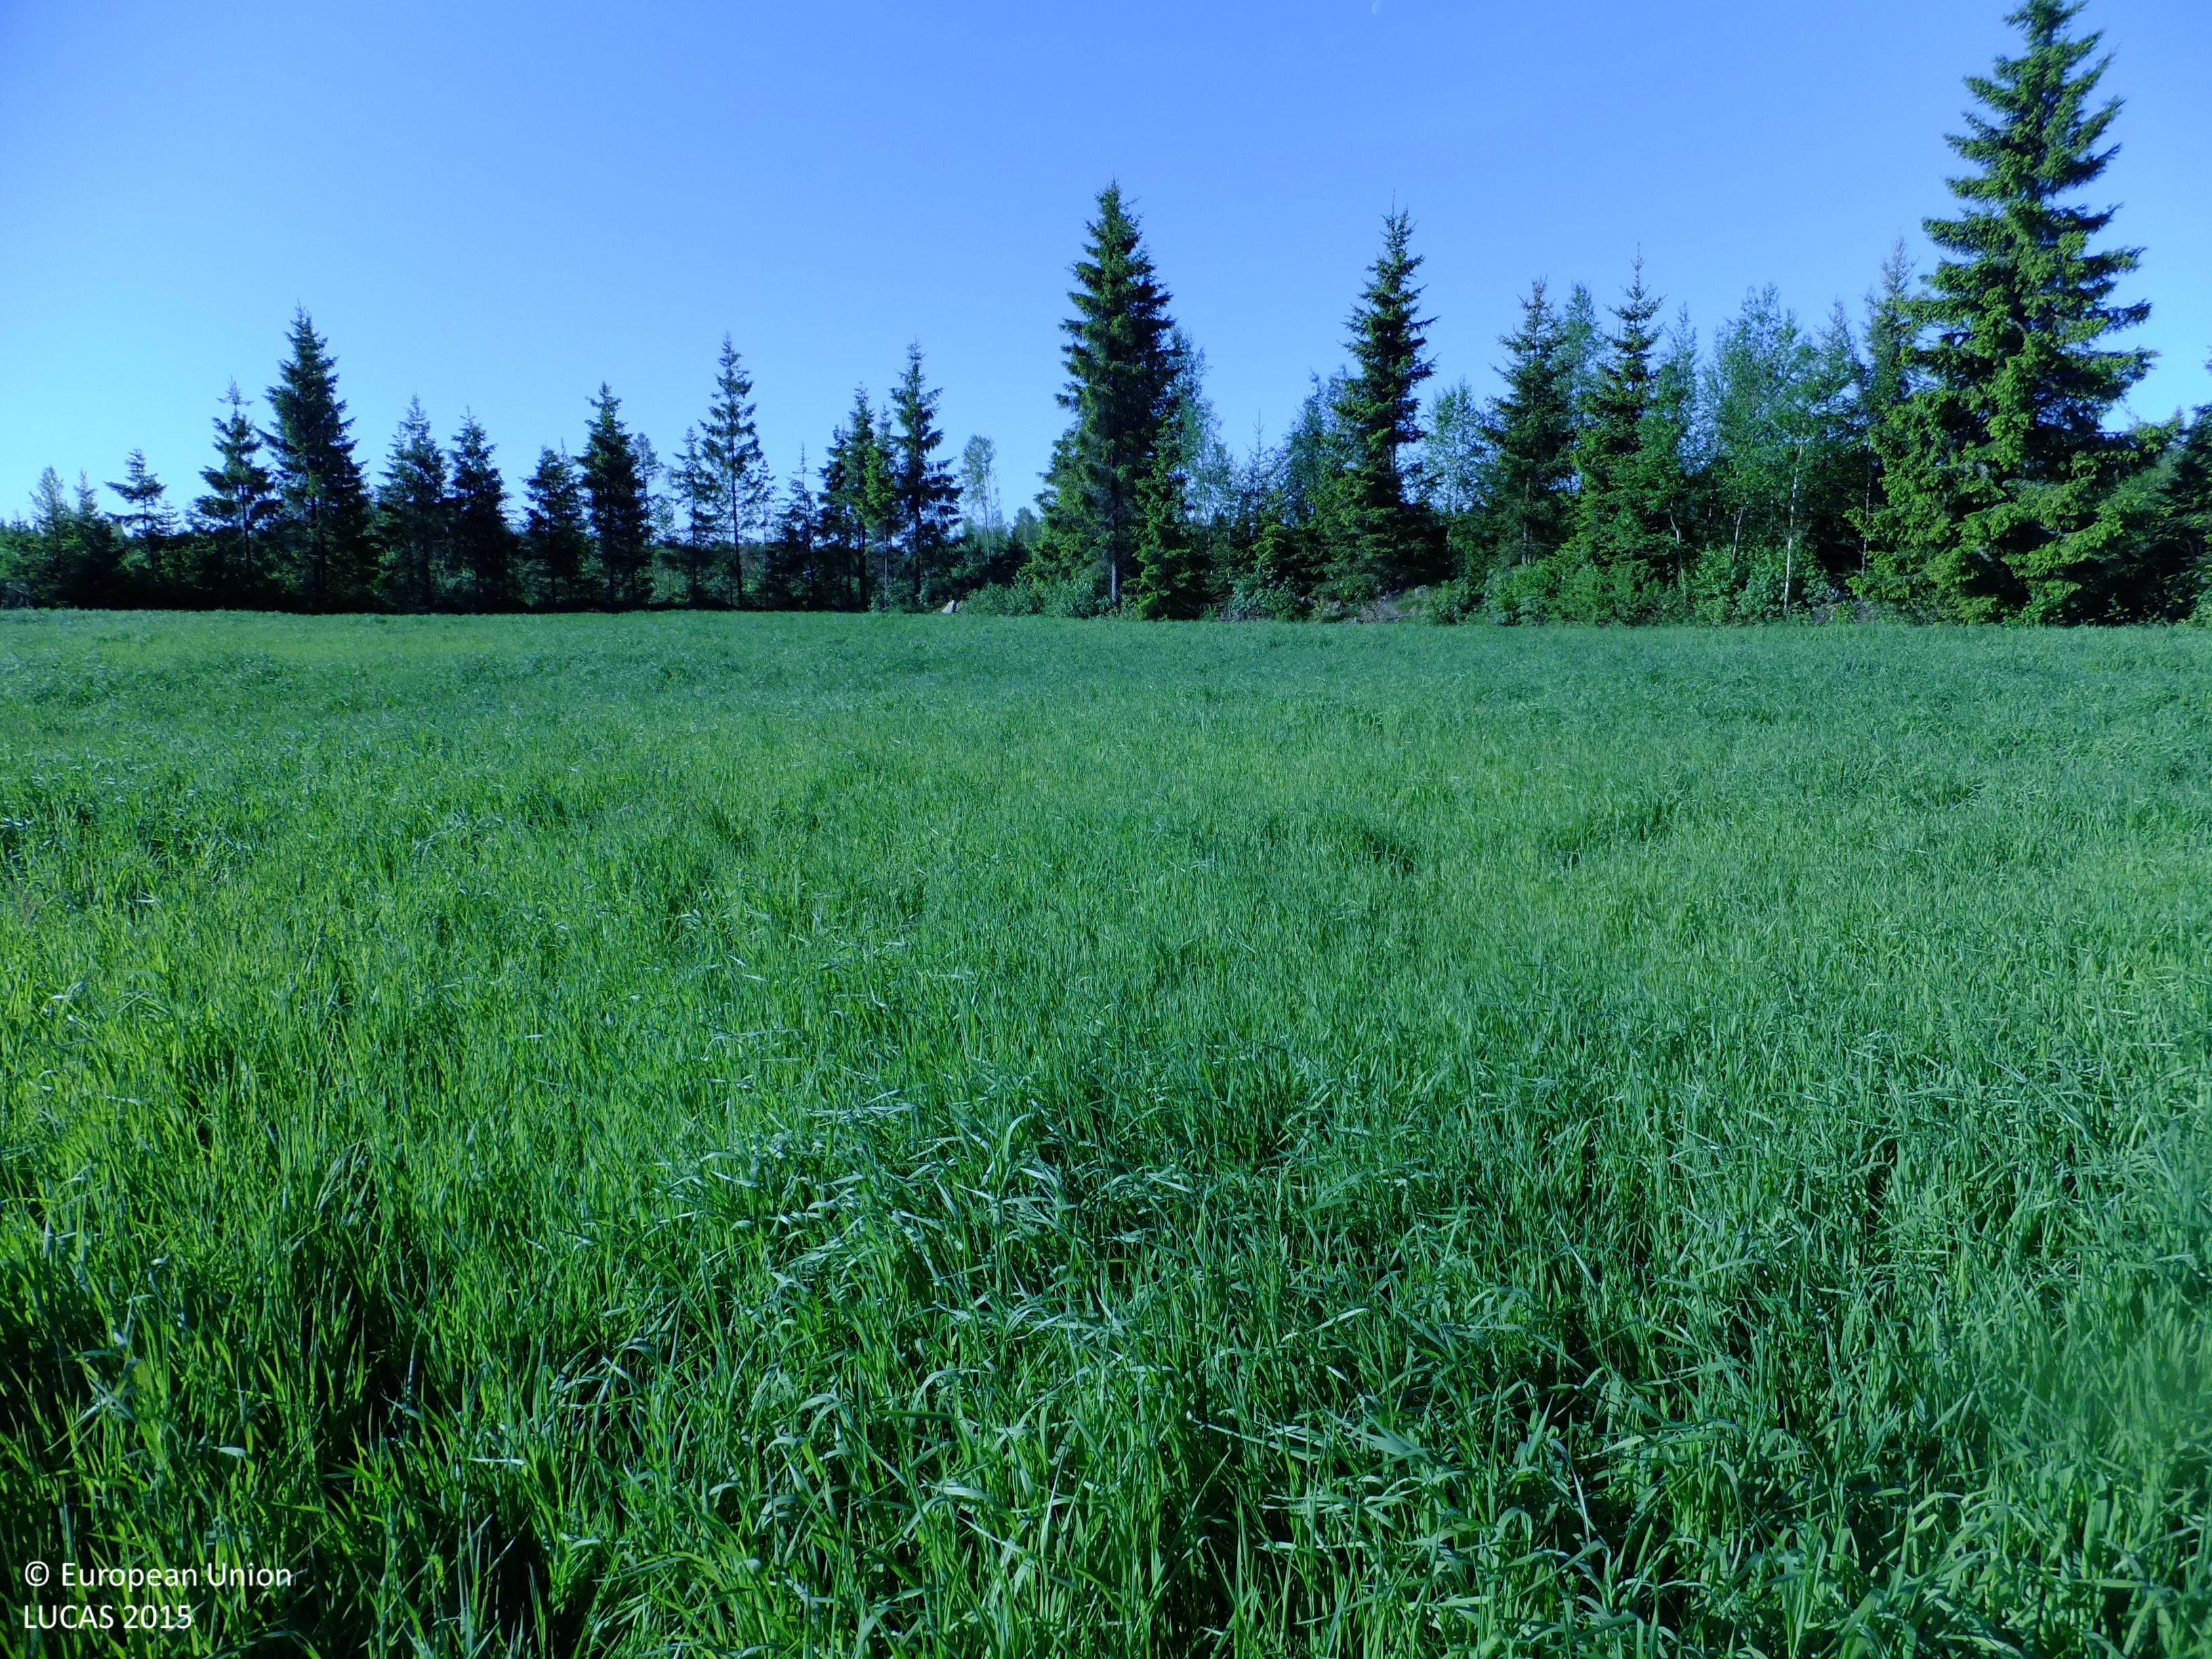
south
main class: Cropland
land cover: Temporary grasslands
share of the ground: > 75 %
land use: Agriculture (excluding fallow land and kitchen gardens)
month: June
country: FI
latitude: 63.4520
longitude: 22.6233
